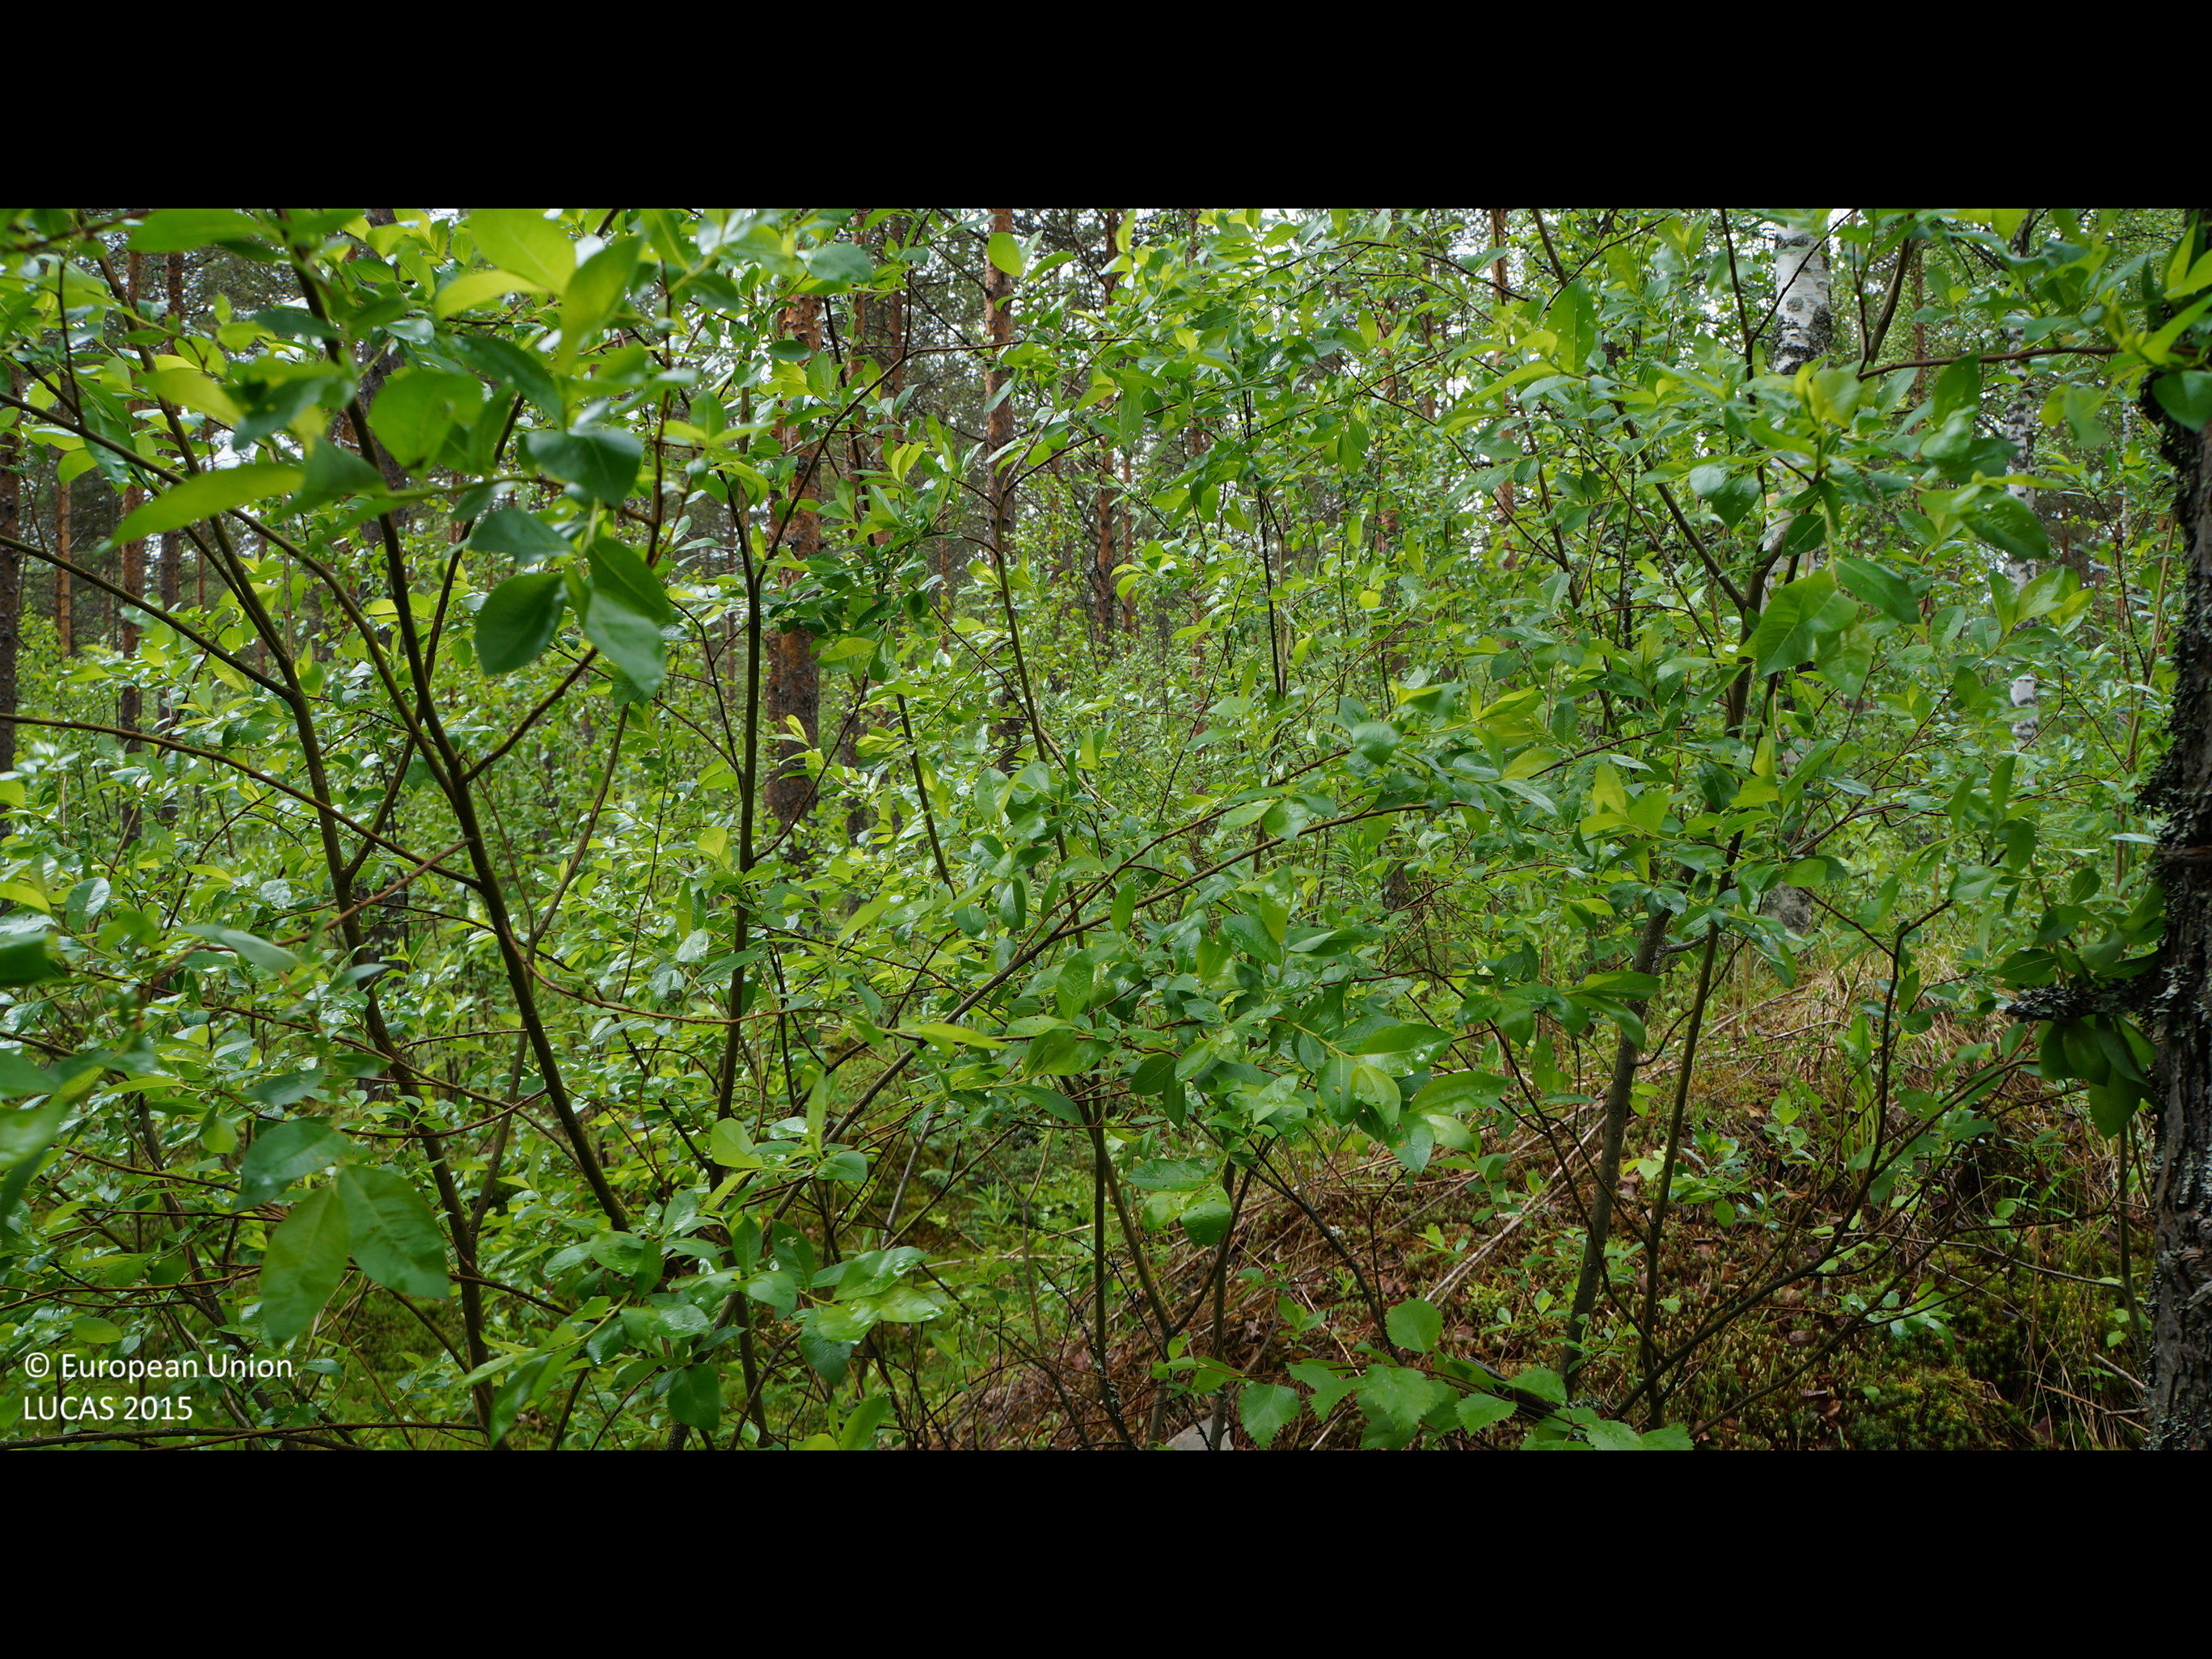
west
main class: Woodland
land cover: Pine dominated mixed woodland
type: boreal forest
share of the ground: 50 - 75 %
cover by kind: coniferous forest trees 50 %, broadleaved forest trees 20 %, shrubs 20 %, herbaceous plants 5 %, lichens and mosses 5 %
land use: Forestry
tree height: > 5 m
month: June
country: FI
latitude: 64.2693
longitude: 25.3879
